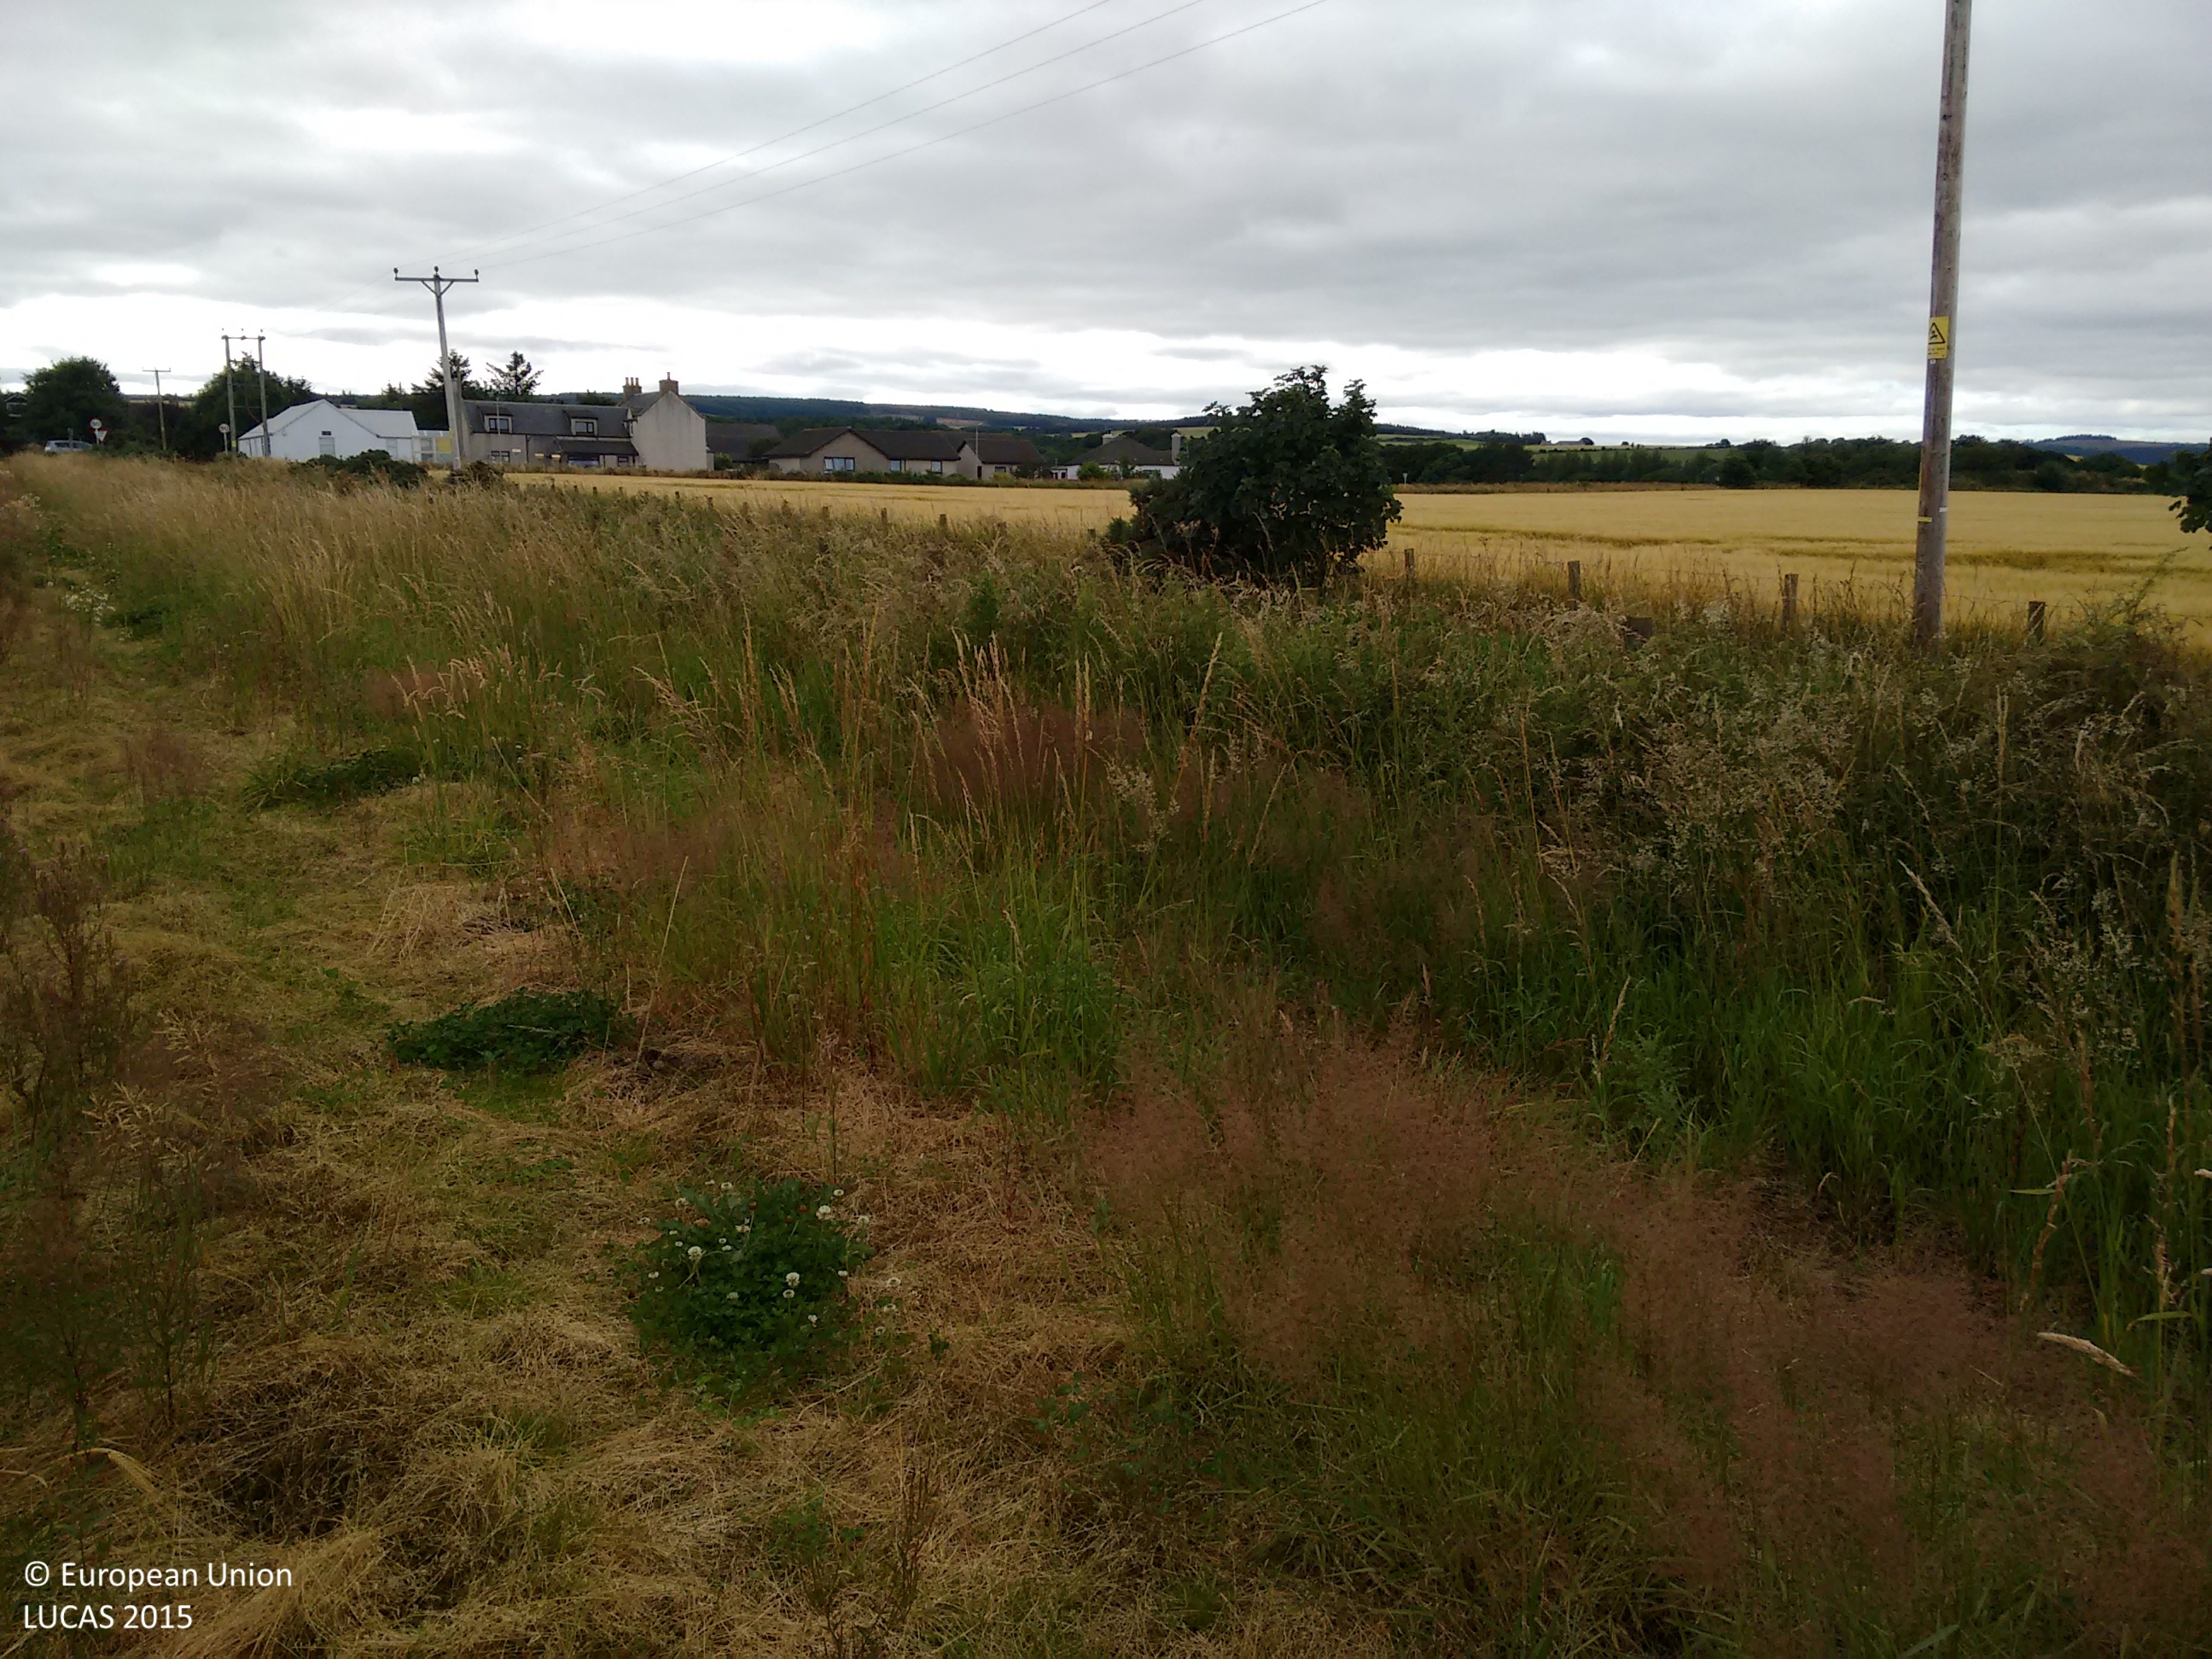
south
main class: Cropland
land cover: Barley
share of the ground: > 75 %
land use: Agriculture (excluding fallow land and kitchen gardens)
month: August
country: GB
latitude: 57.6593
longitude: -2.9823
